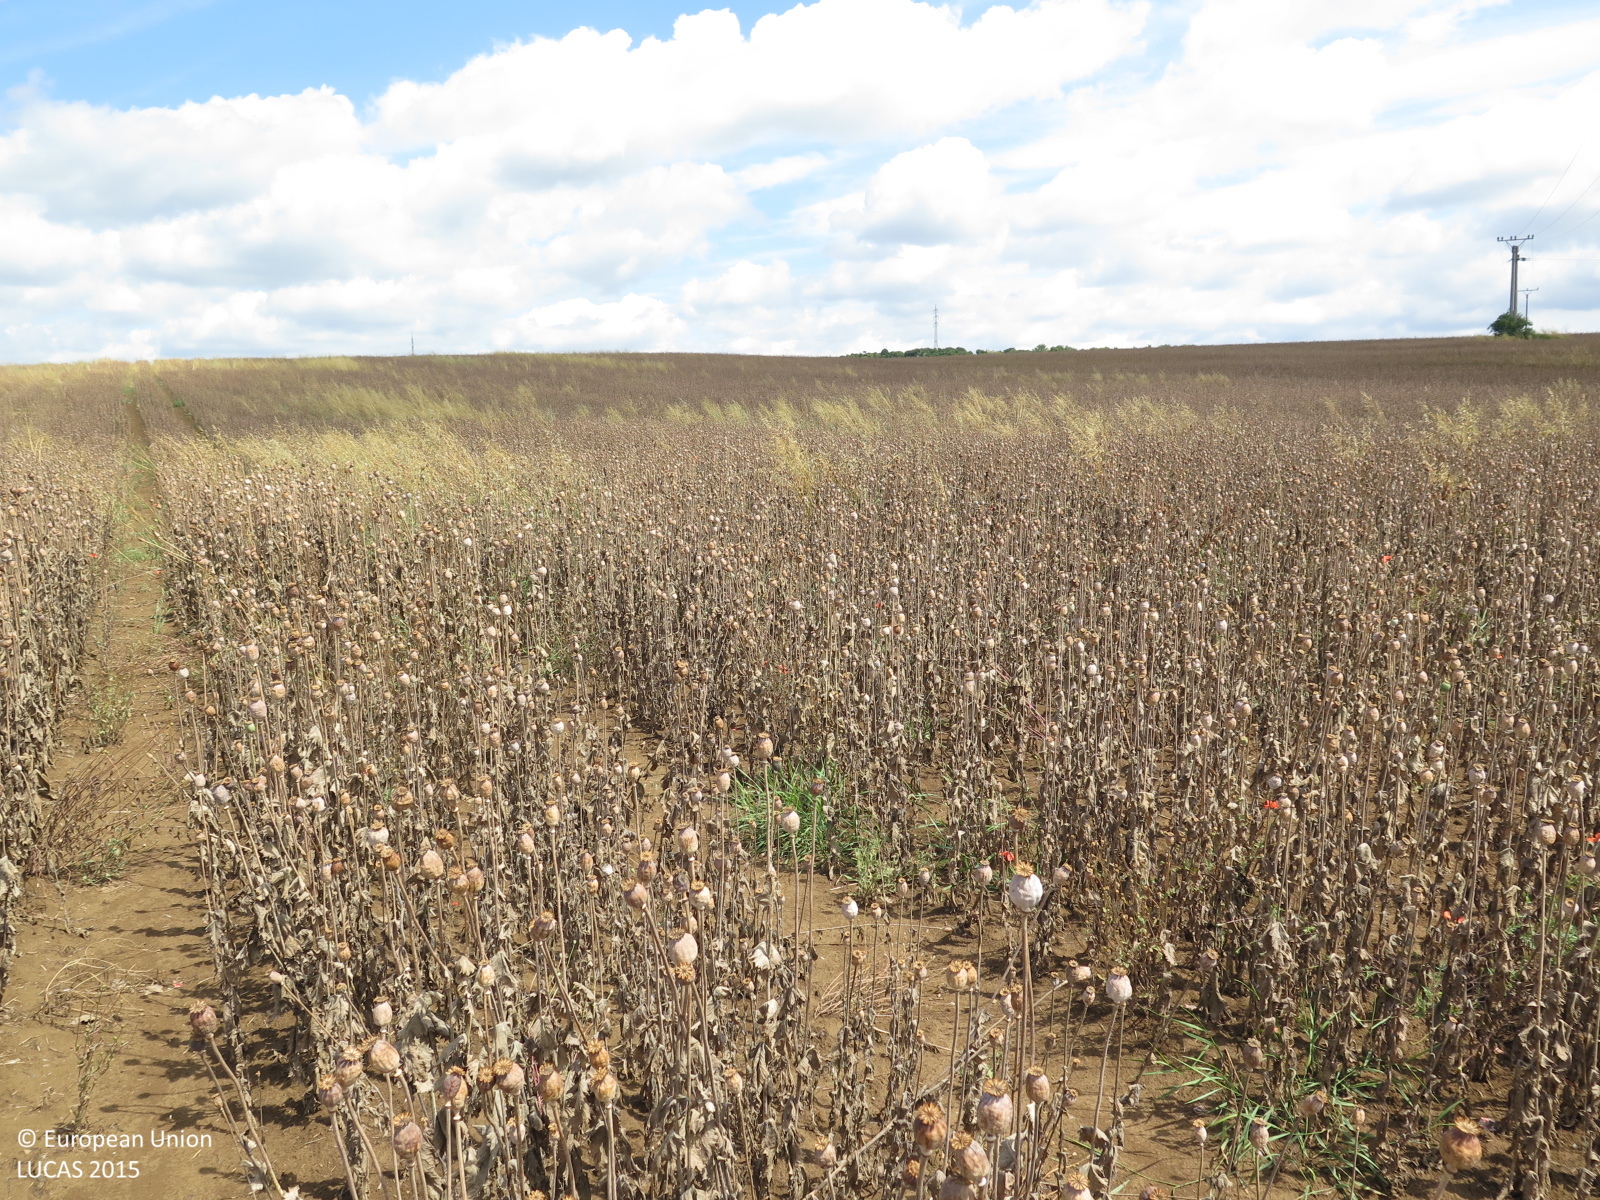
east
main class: Cropland
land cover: Other fibre and oleaginous crops
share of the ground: > 75 %
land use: Agriculture (excluding fallow land and kitchen gardens)
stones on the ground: < 10 %
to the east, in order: Other fibre and oleaginous crops
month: July
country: CZ
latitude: 49.1022
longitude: 17.5589
